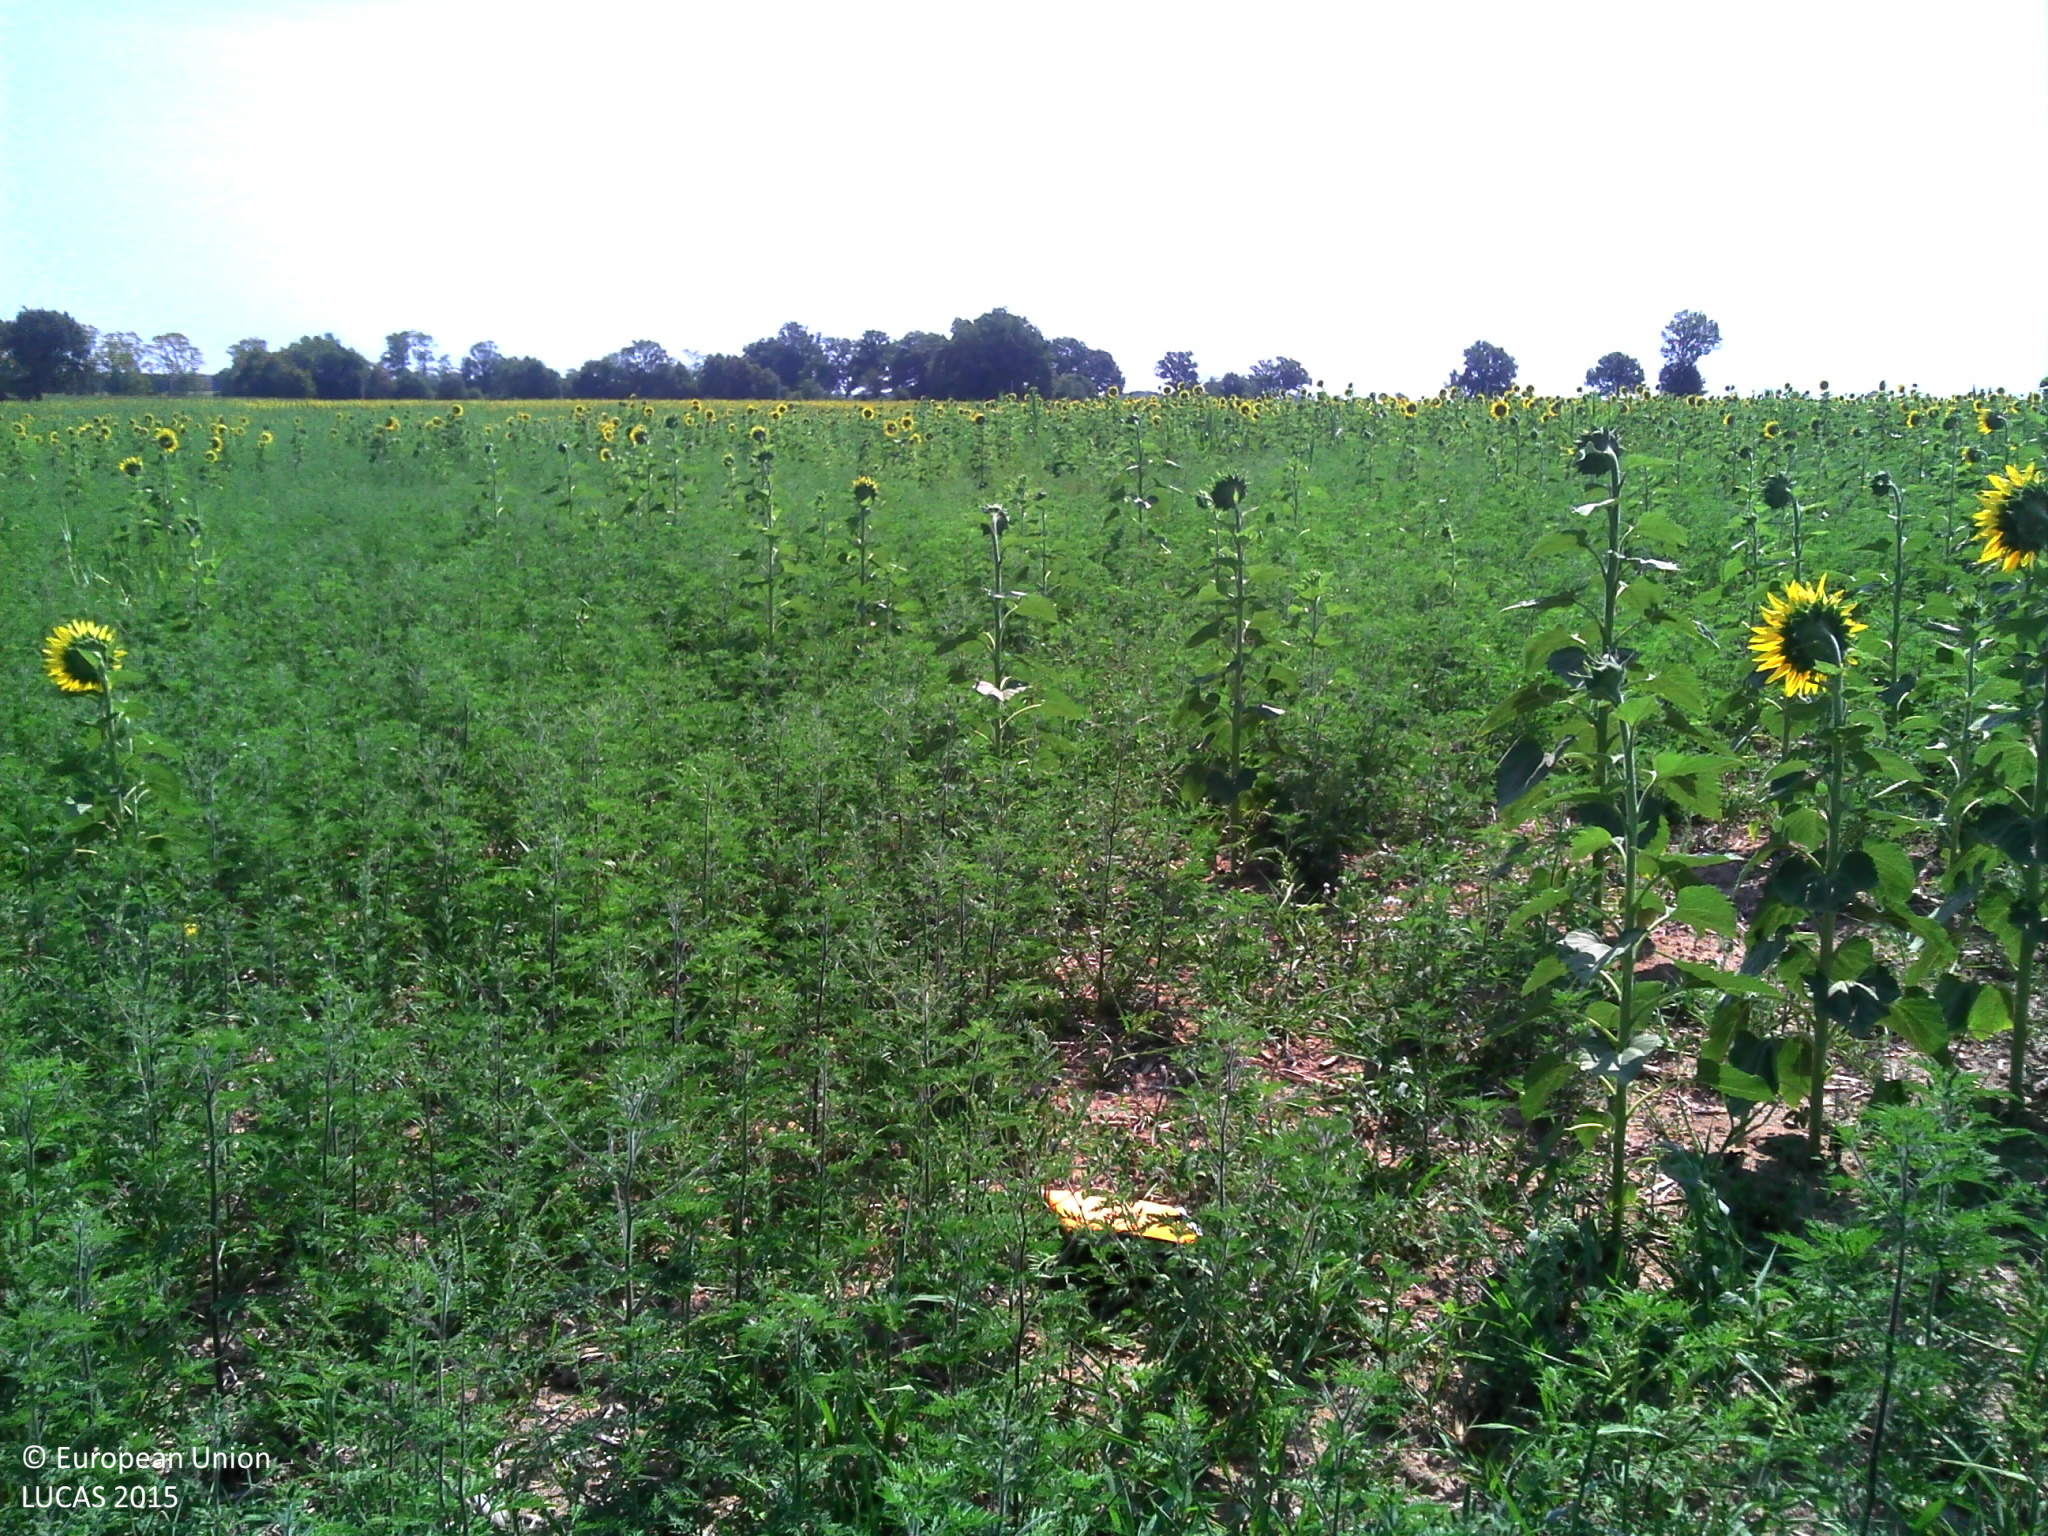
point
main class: Cropland
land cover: Sunflower
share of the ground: 50 - 75 %
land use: Agriculture (excluding fallow land and kitchen gardens)
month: August
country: FR
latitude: 46.6775
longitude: 2.6614
